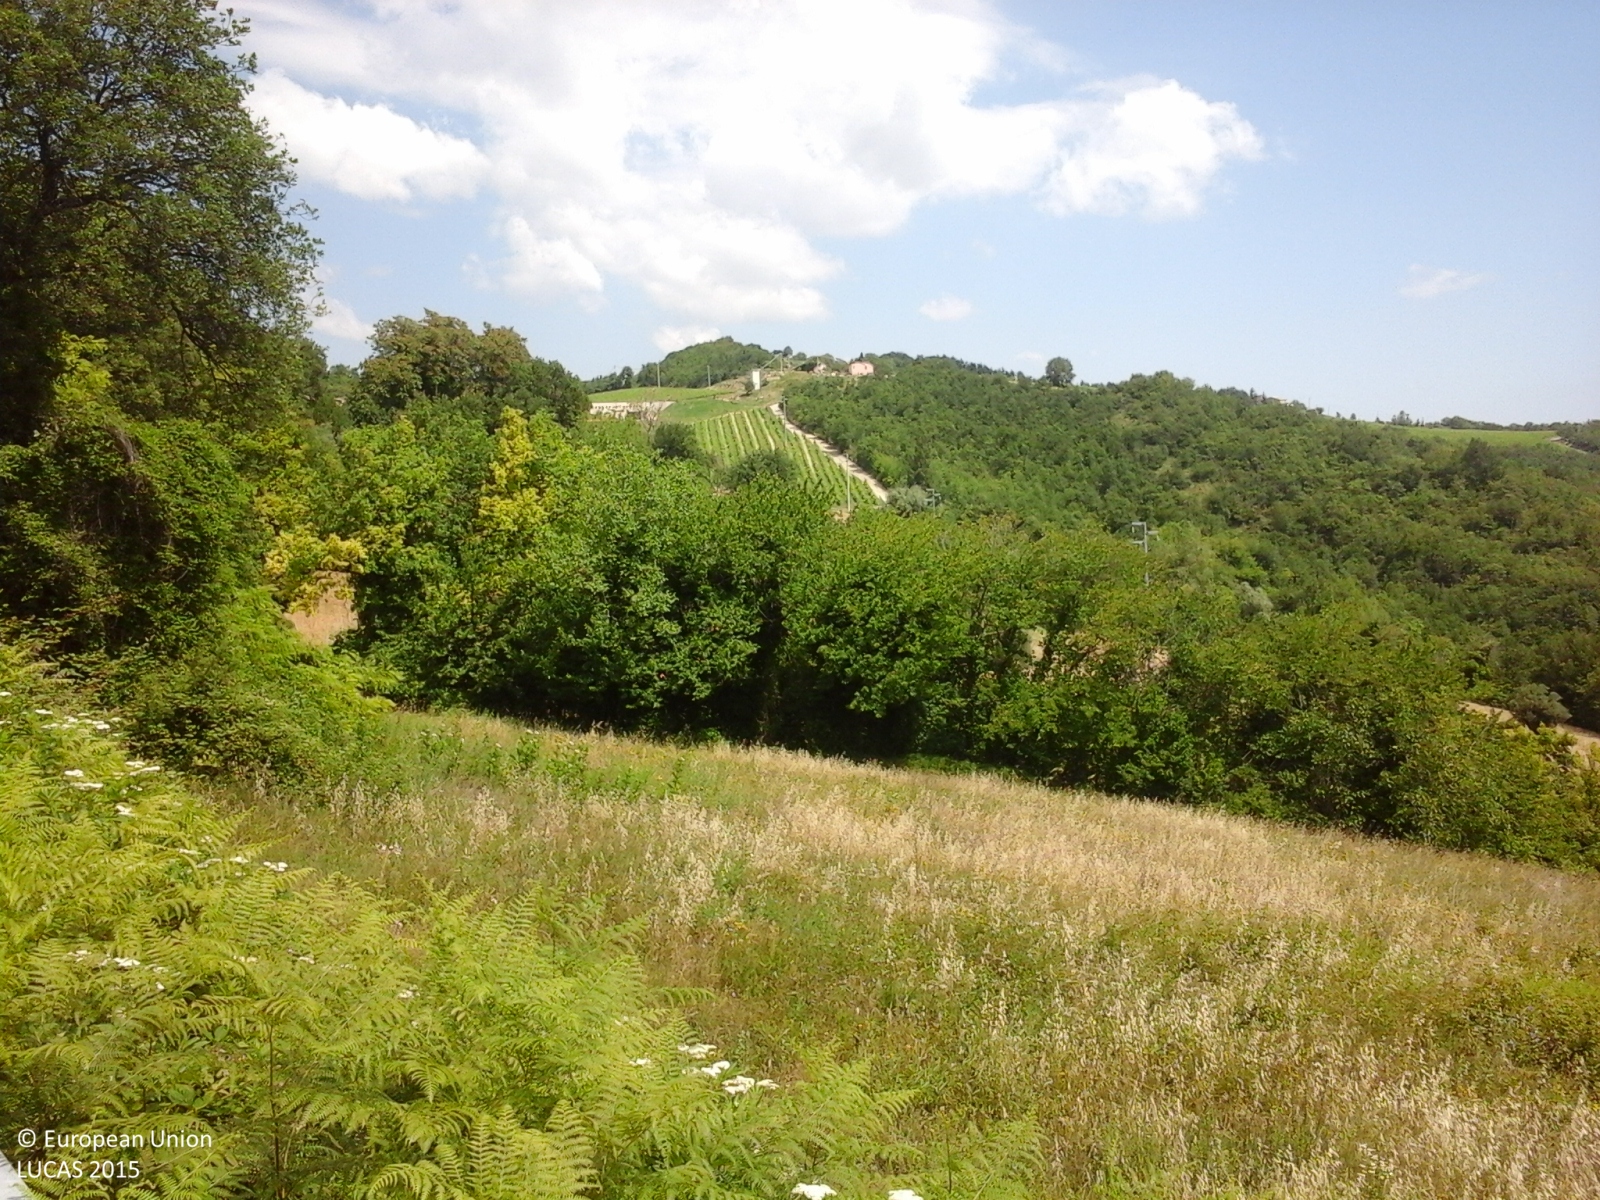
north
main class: Woodland
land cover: Broadleaved woodland
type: thermophilous deciduous forest
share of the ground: > 75 %
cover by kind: broadleaved forest trees 90 %, shrubs 5 %, herbaceous plants 5 %
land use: Forestry
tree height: > 5 m
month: June
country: IT
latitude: 43.1636
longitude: 13.2015
